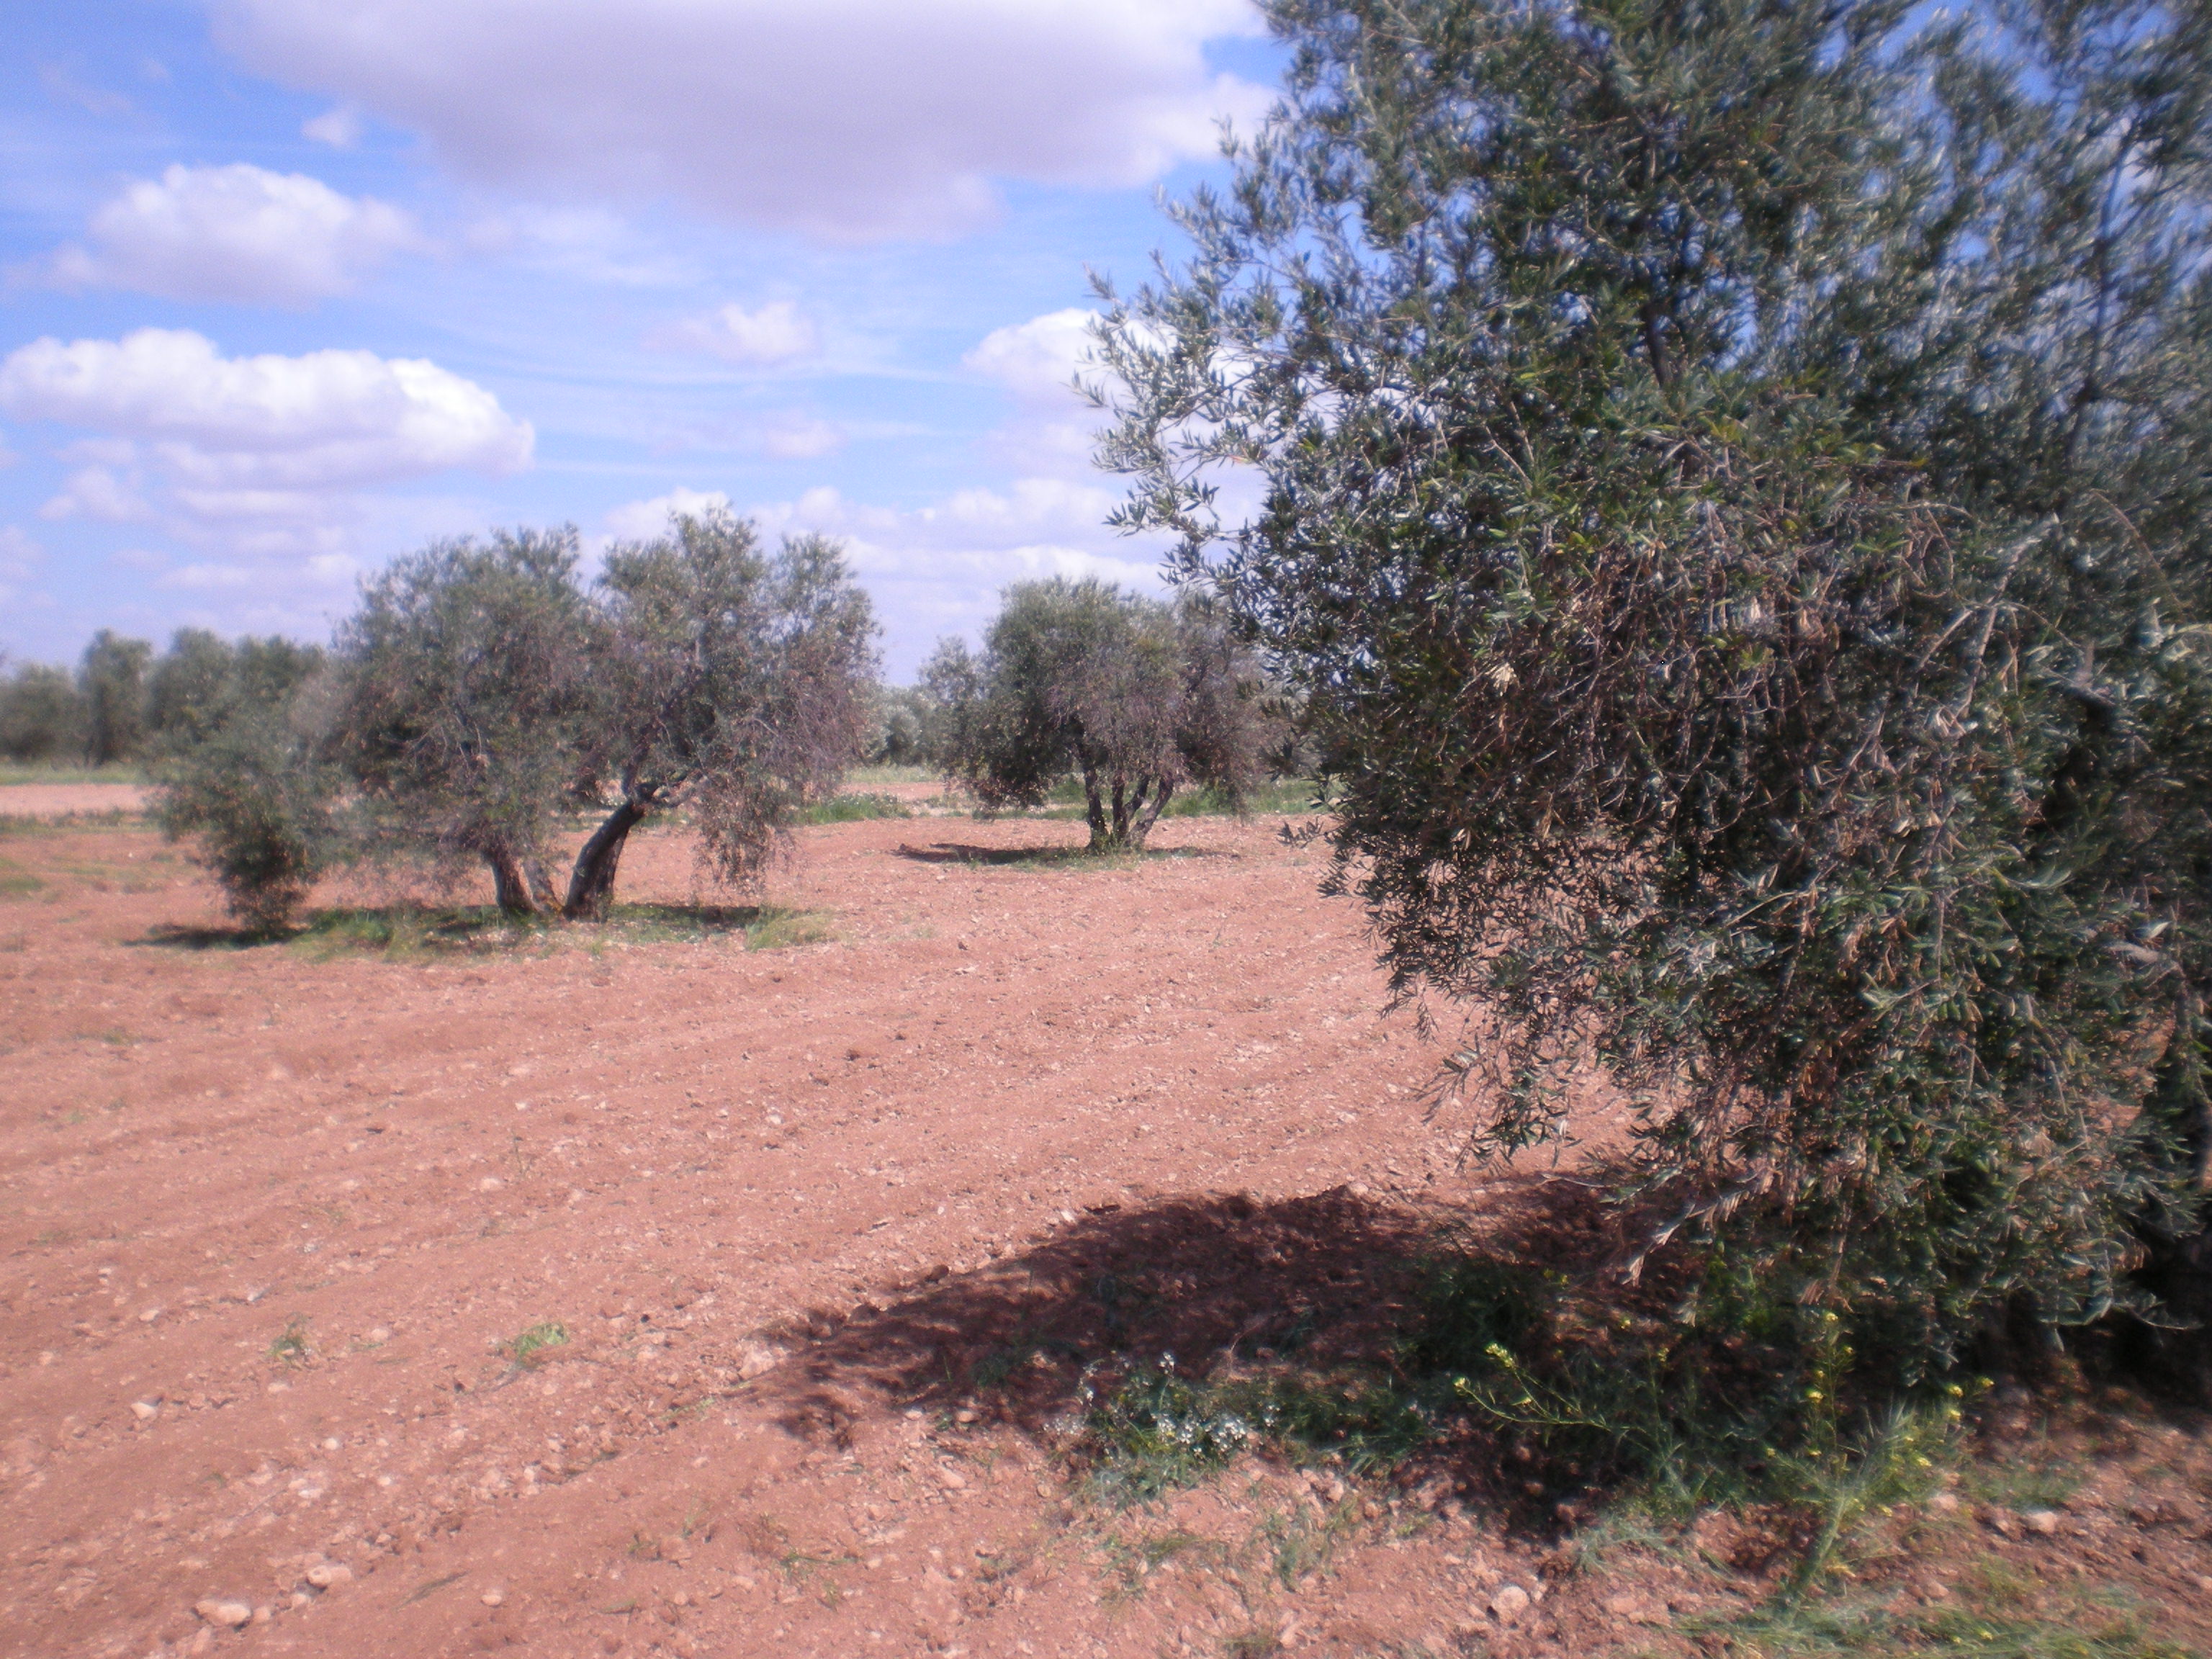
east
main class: Cropland
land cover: Olive groves
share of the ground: 10 - 25 %
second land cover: Other bare soil
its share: > 75 %
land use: Agriculture (excluding fallow land and kitchen gardens)
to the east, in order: Olive groves; Other bare soil; Grass margins; Tracks; Grass margins; Other bare soil; Olive groves; Grass margins; Other bare soil; Grass margins
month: April
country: ES
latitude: 38.6676
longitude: -3.5154
